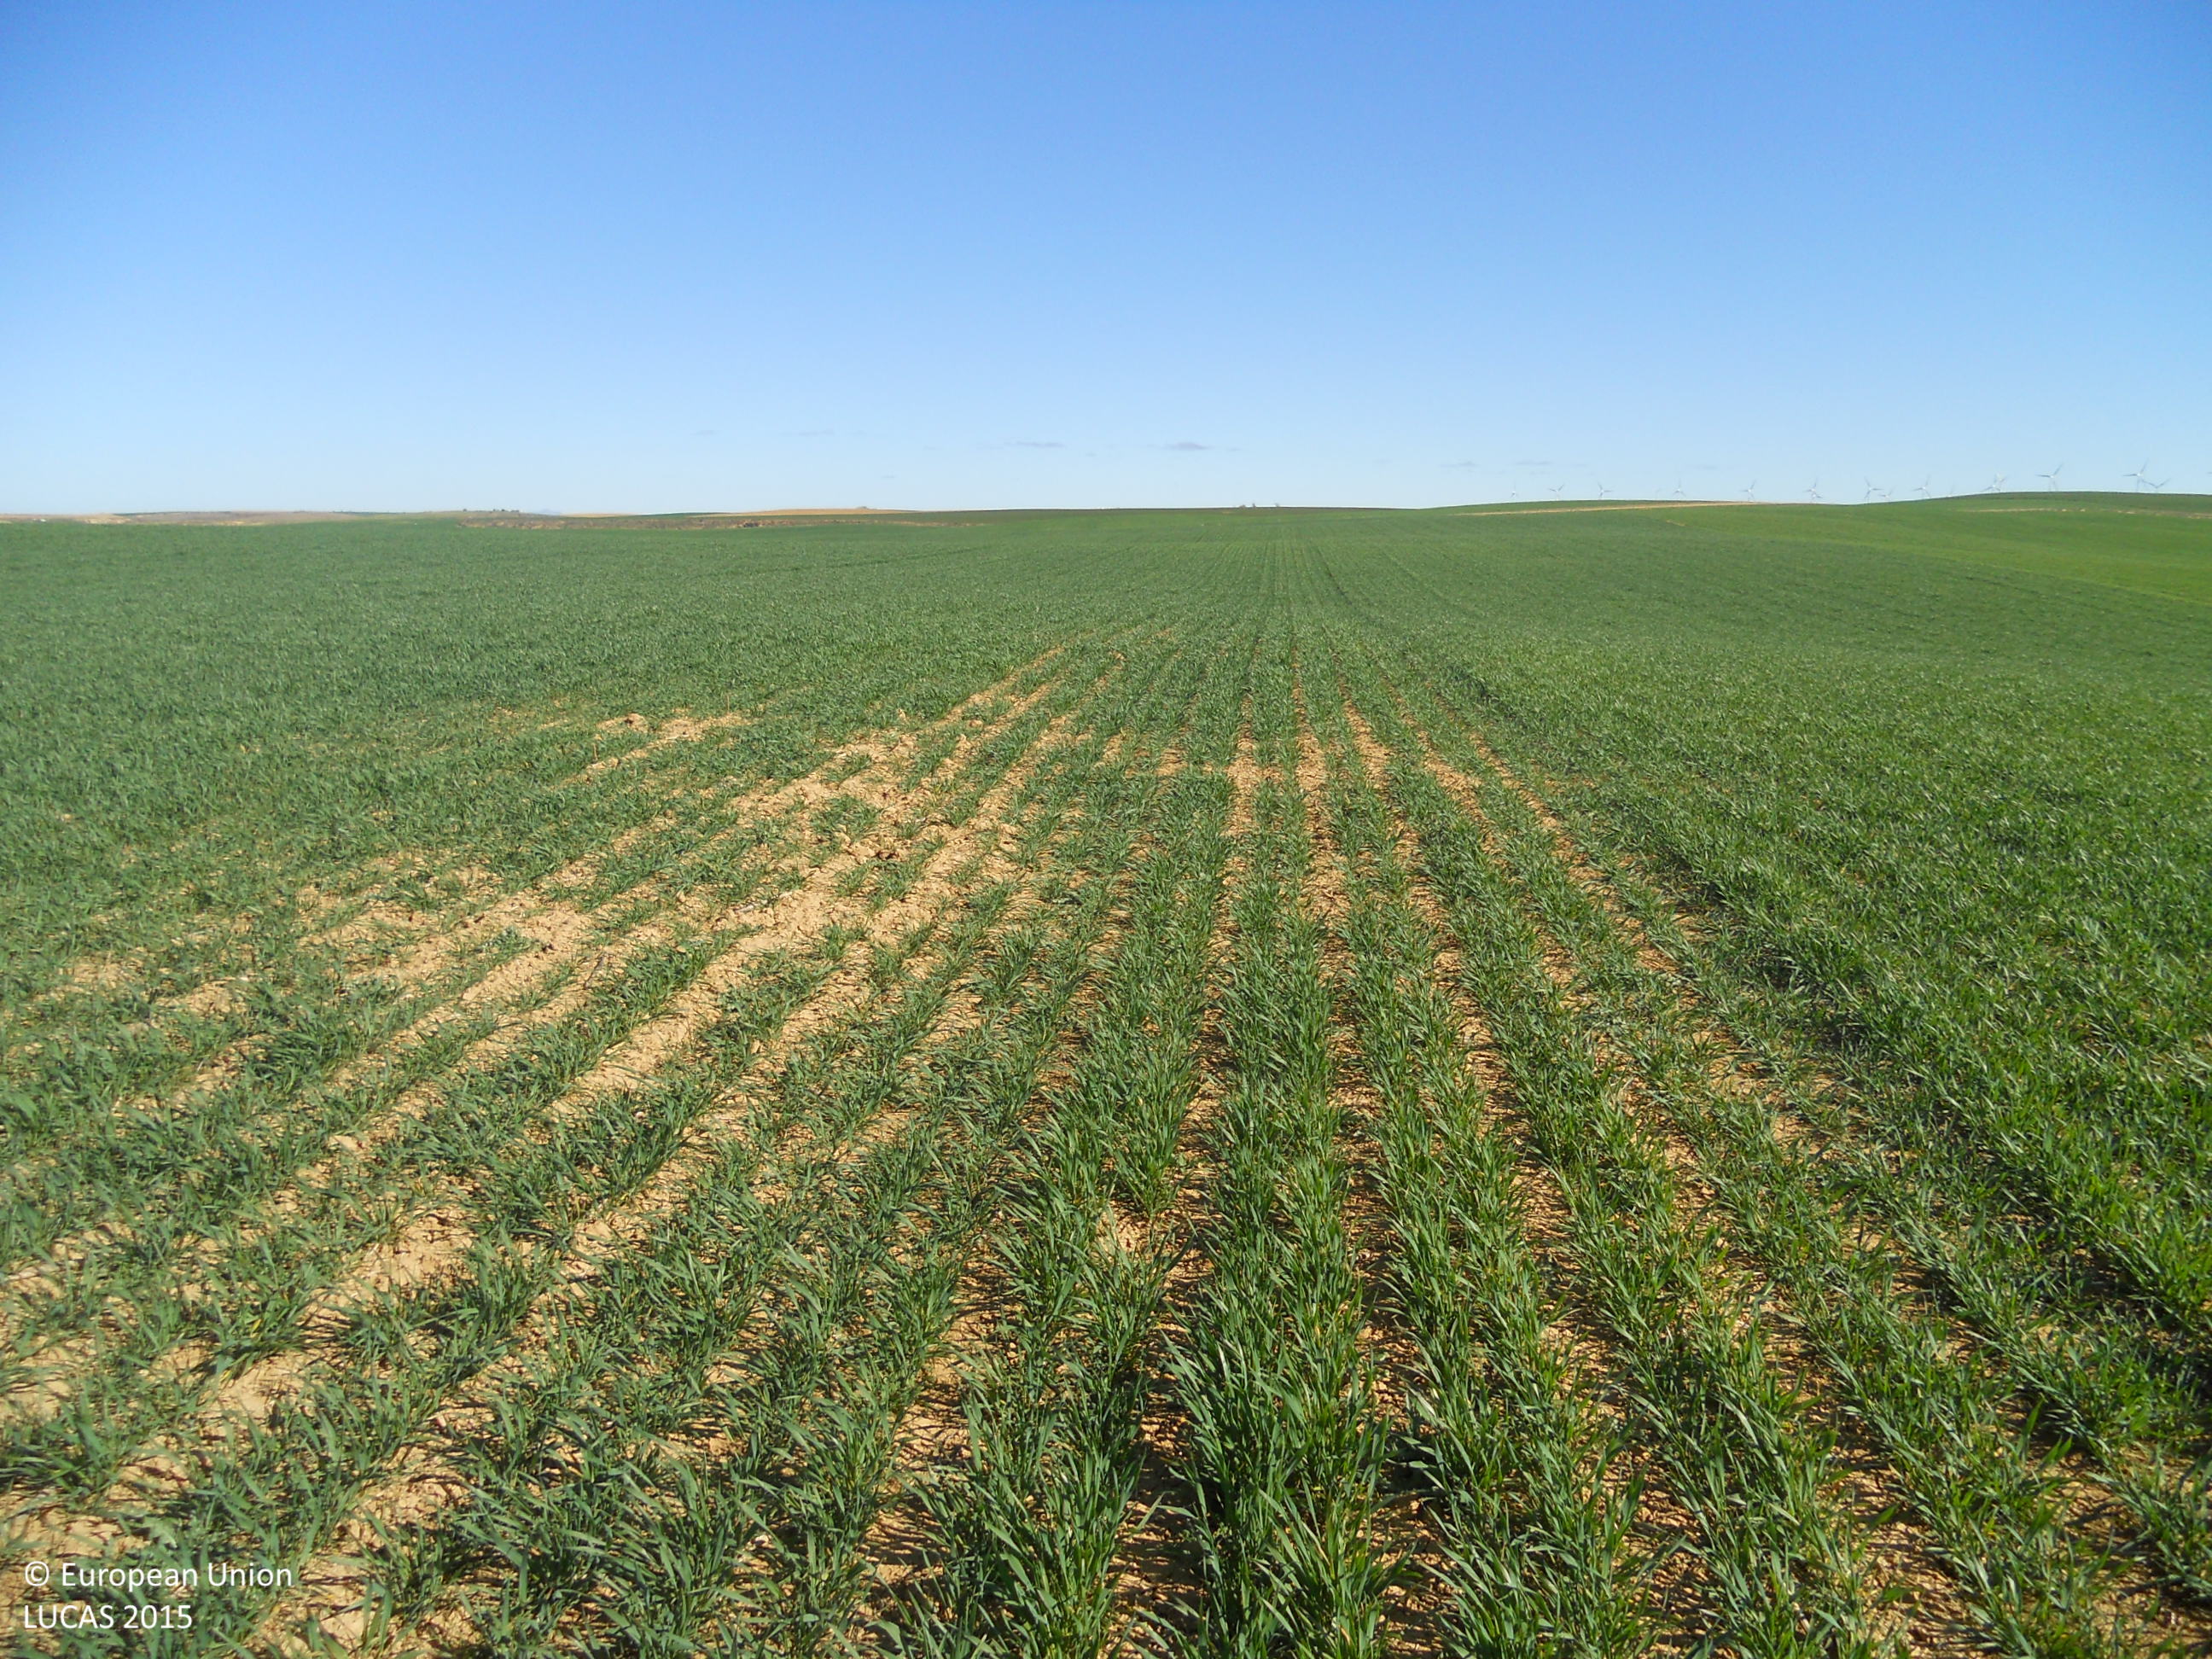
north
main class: Cropland
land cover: Barley
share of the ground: > 75 %
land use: Agriculture (excluding fallow land and kitchen gardens)
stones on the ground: < 10 %
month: April
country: ES
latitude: 42.2096
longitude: -4.7447
